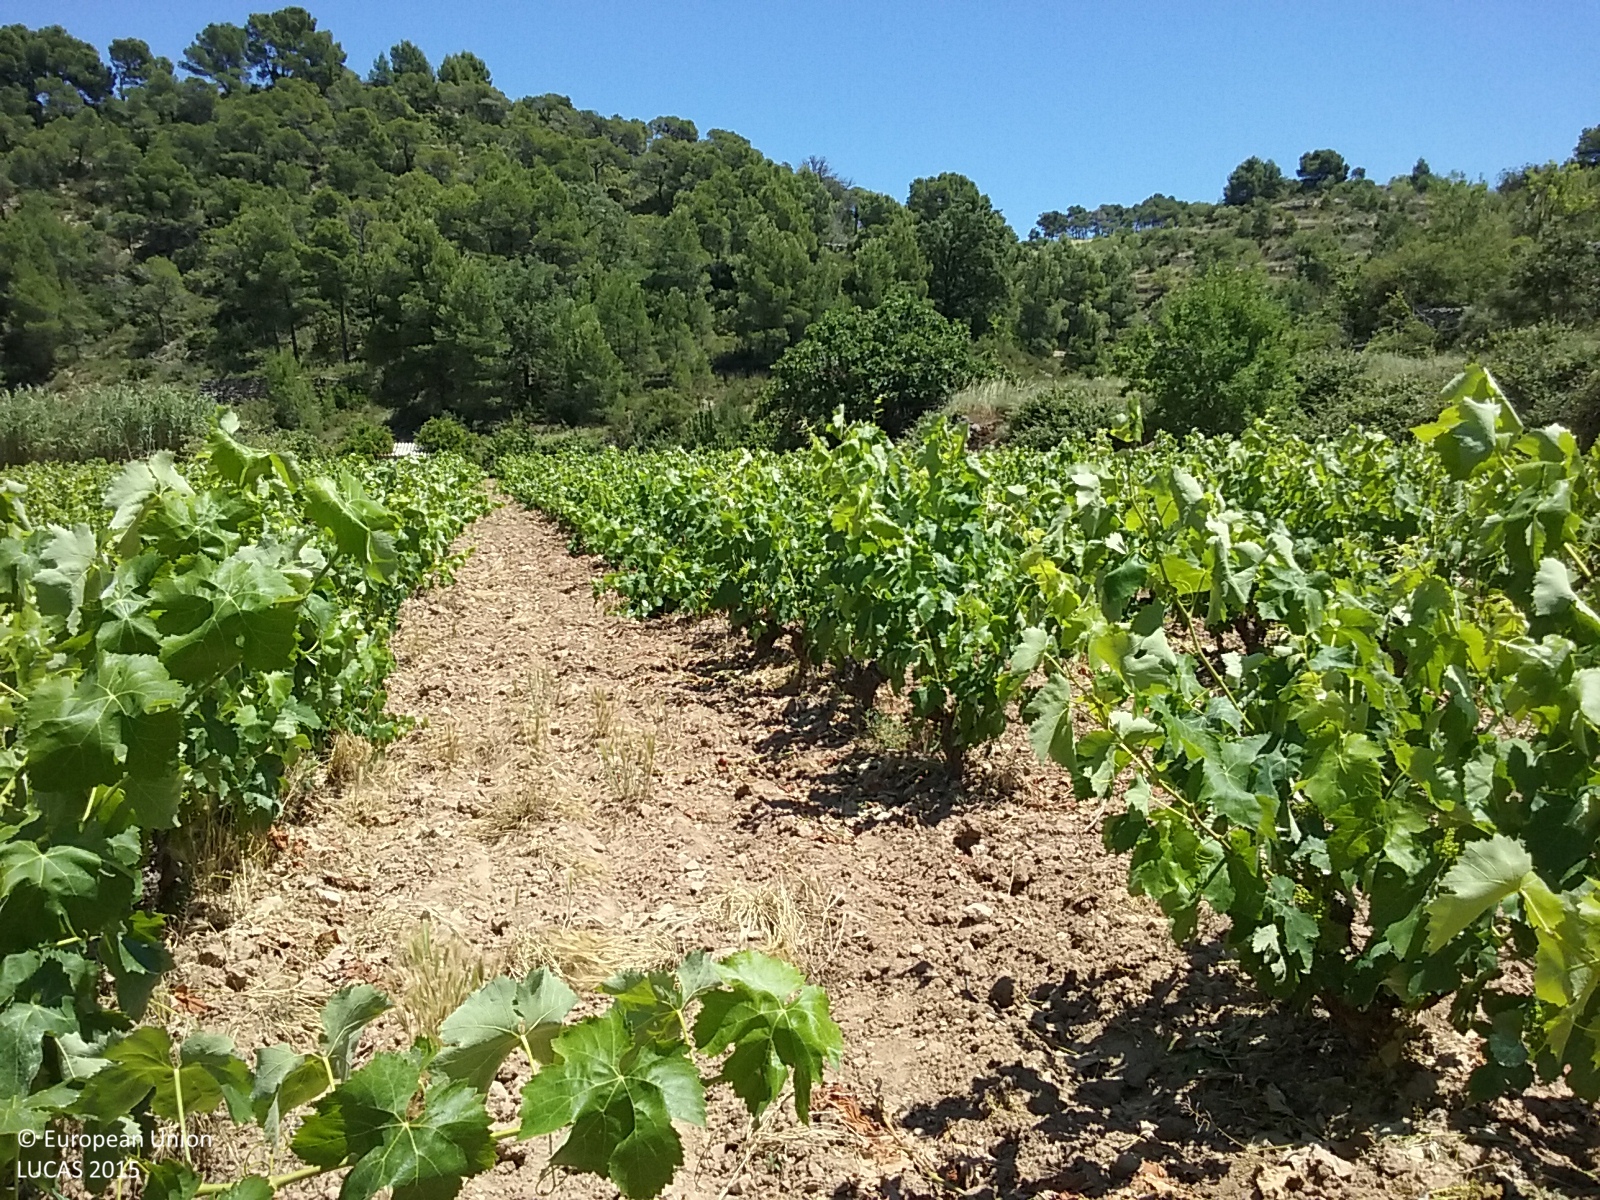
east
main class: Cropland
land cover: Vineyards
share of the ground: < 10 %
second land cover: Other bare soil
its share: > 75 %
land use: Agriculture (excluding fallow land and kitchen gardens)
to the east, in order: Vineyards; Other bare soil; Dry stone walls; Grassland without tree/shrub cover; Pine dominated coniferous woodland
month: June
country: ES
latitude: 41.1043
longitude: 0.3816
